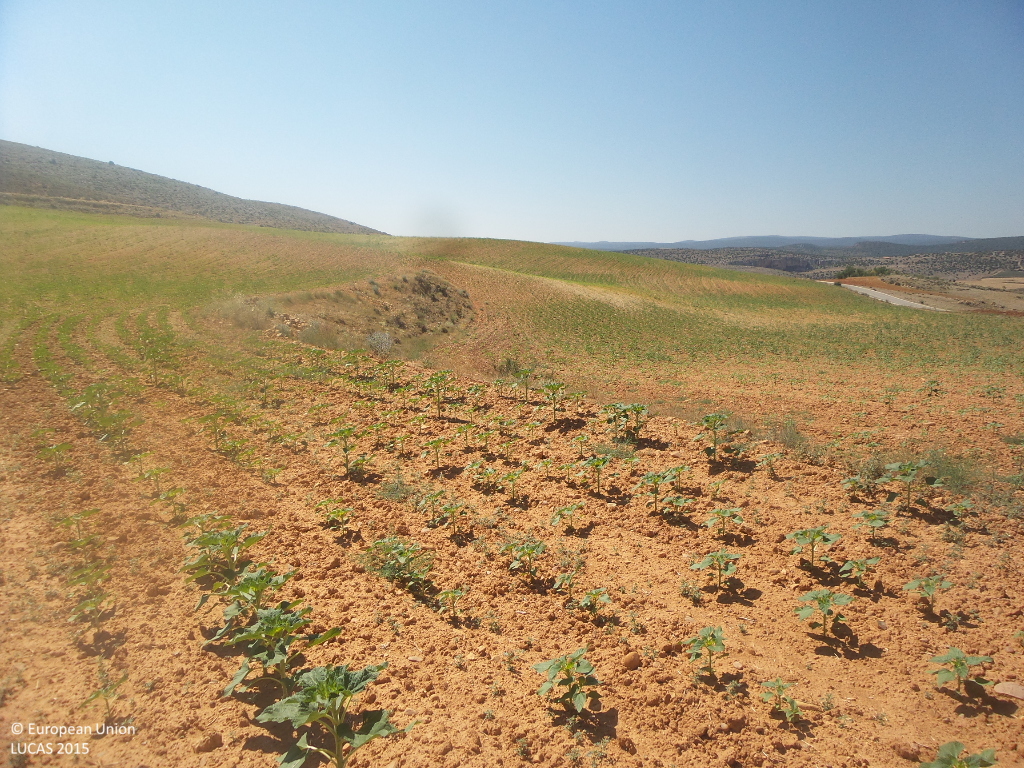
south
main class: Cropland
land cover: Sunflower
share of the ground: < 10 %
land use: Agriculture (excluding fallow land and kitchen gardens)
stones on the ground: < 10 %
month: July
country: ES
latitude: 41.1794
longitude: -1.9352
